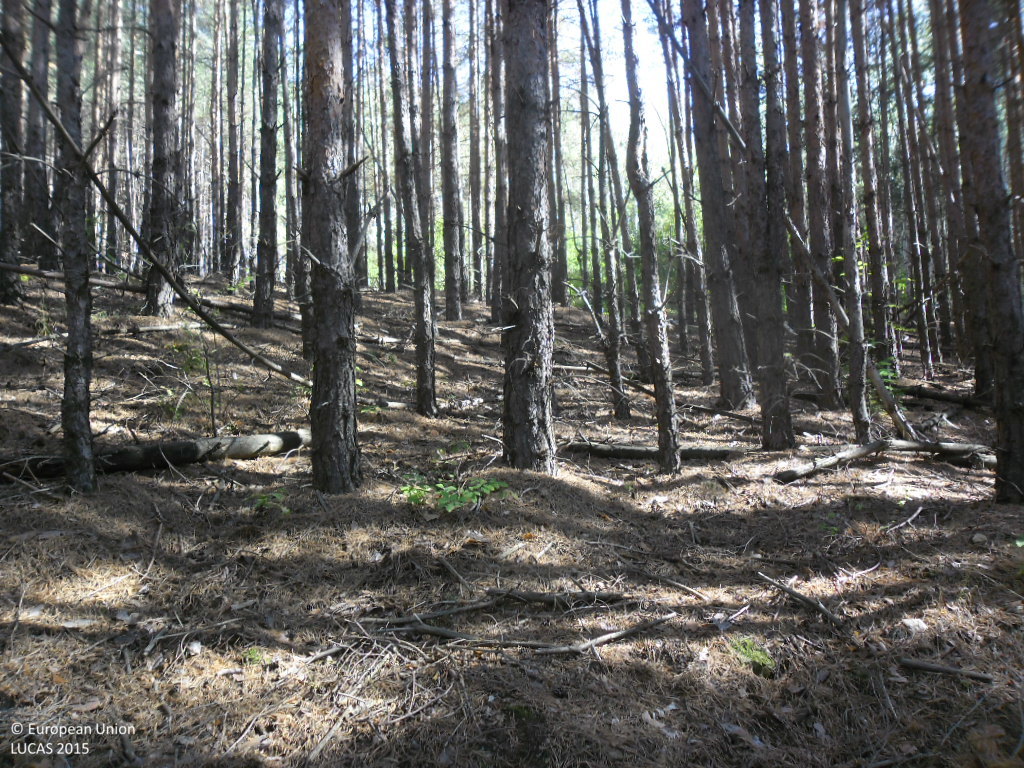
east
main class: Woodland
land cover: Pine dominated coniferous woodland
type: hemiboreal forest and nemoral coniferous forest and mixed broadleaved-coniferous forest
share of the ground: > 75 %
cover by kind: coniferous forest trees 95 %, unconsolidated bare surface 5 %
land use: Forestry
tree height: > 5 m
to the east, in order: Pine dominated coniferous woodland; Grassland with sparse tree/shrub cover; Other mixed woodland
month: October
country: BG
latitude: 42.1140
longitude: 22.9278
